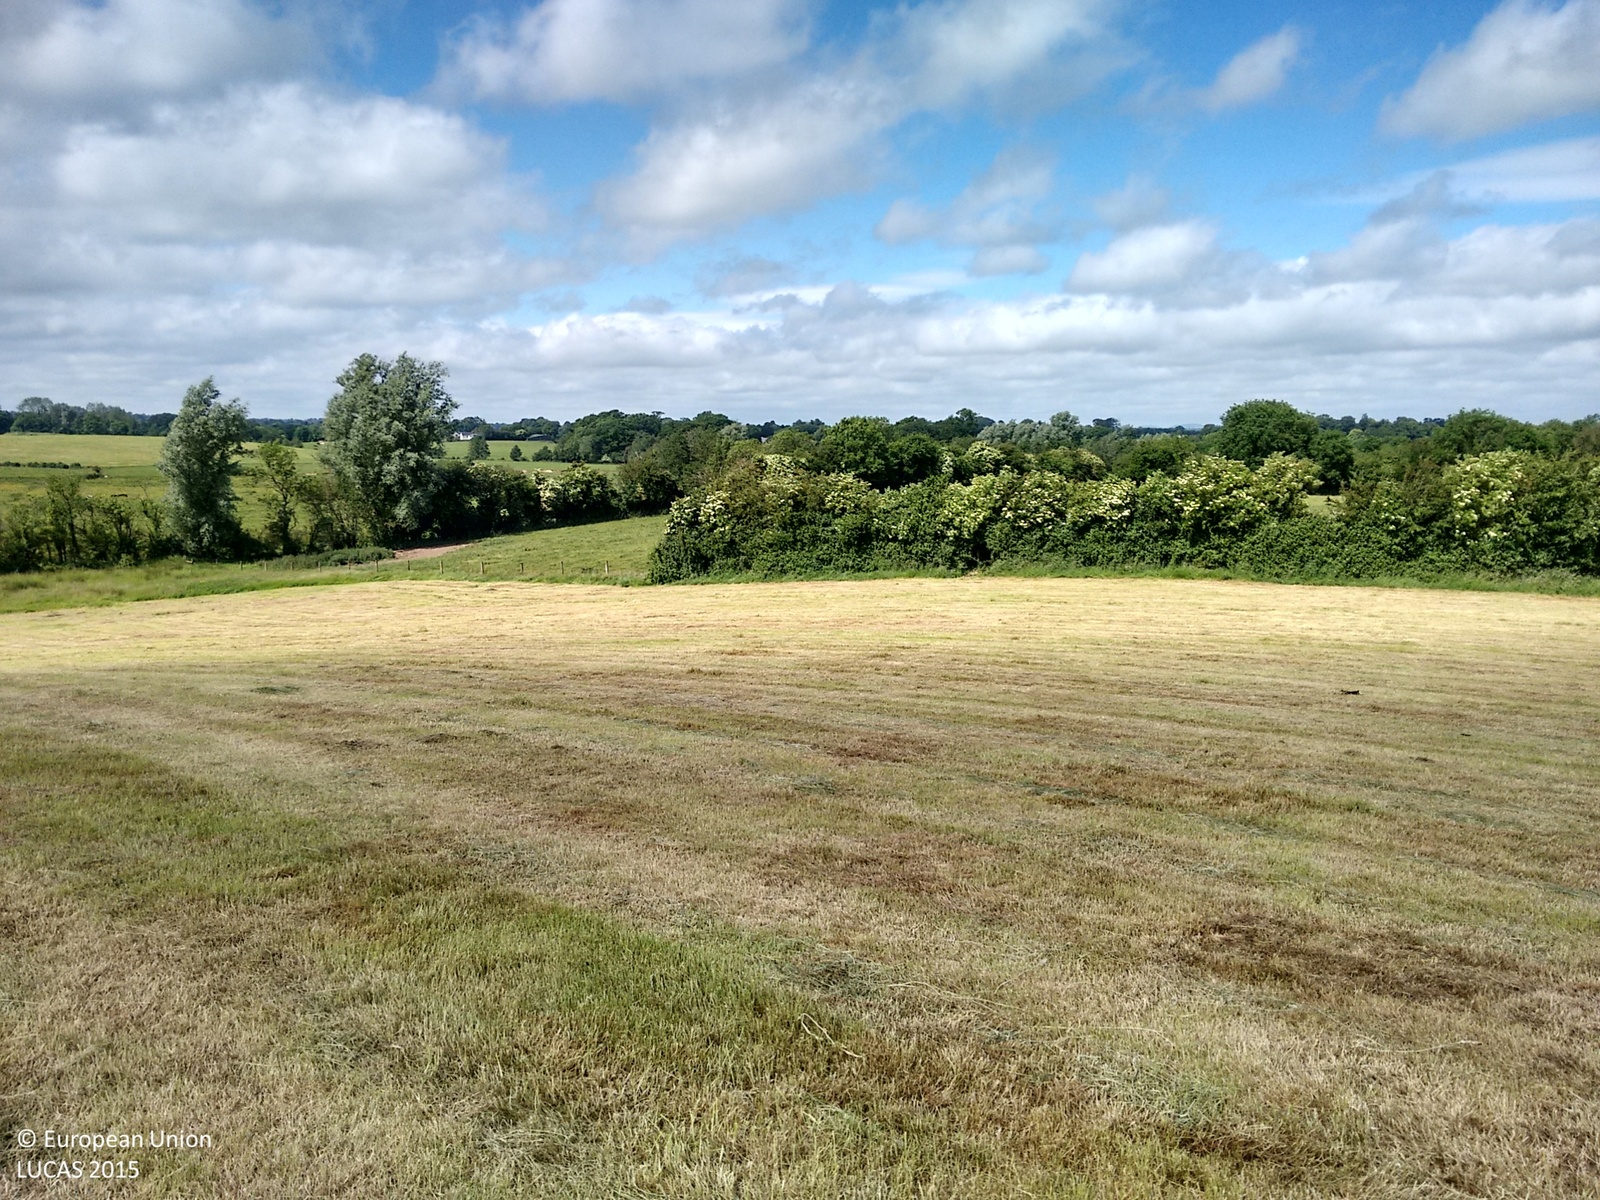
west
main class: Grassland
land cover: Grassland without tree/shrub cover
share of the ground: > 75 %
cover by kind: herbaceous plants 100 %
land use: Agriculture (excluding fallow land and kitchen gardens)
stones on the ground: < 10 %
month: June
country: IE
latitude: 53.7079
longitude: -6.7843
